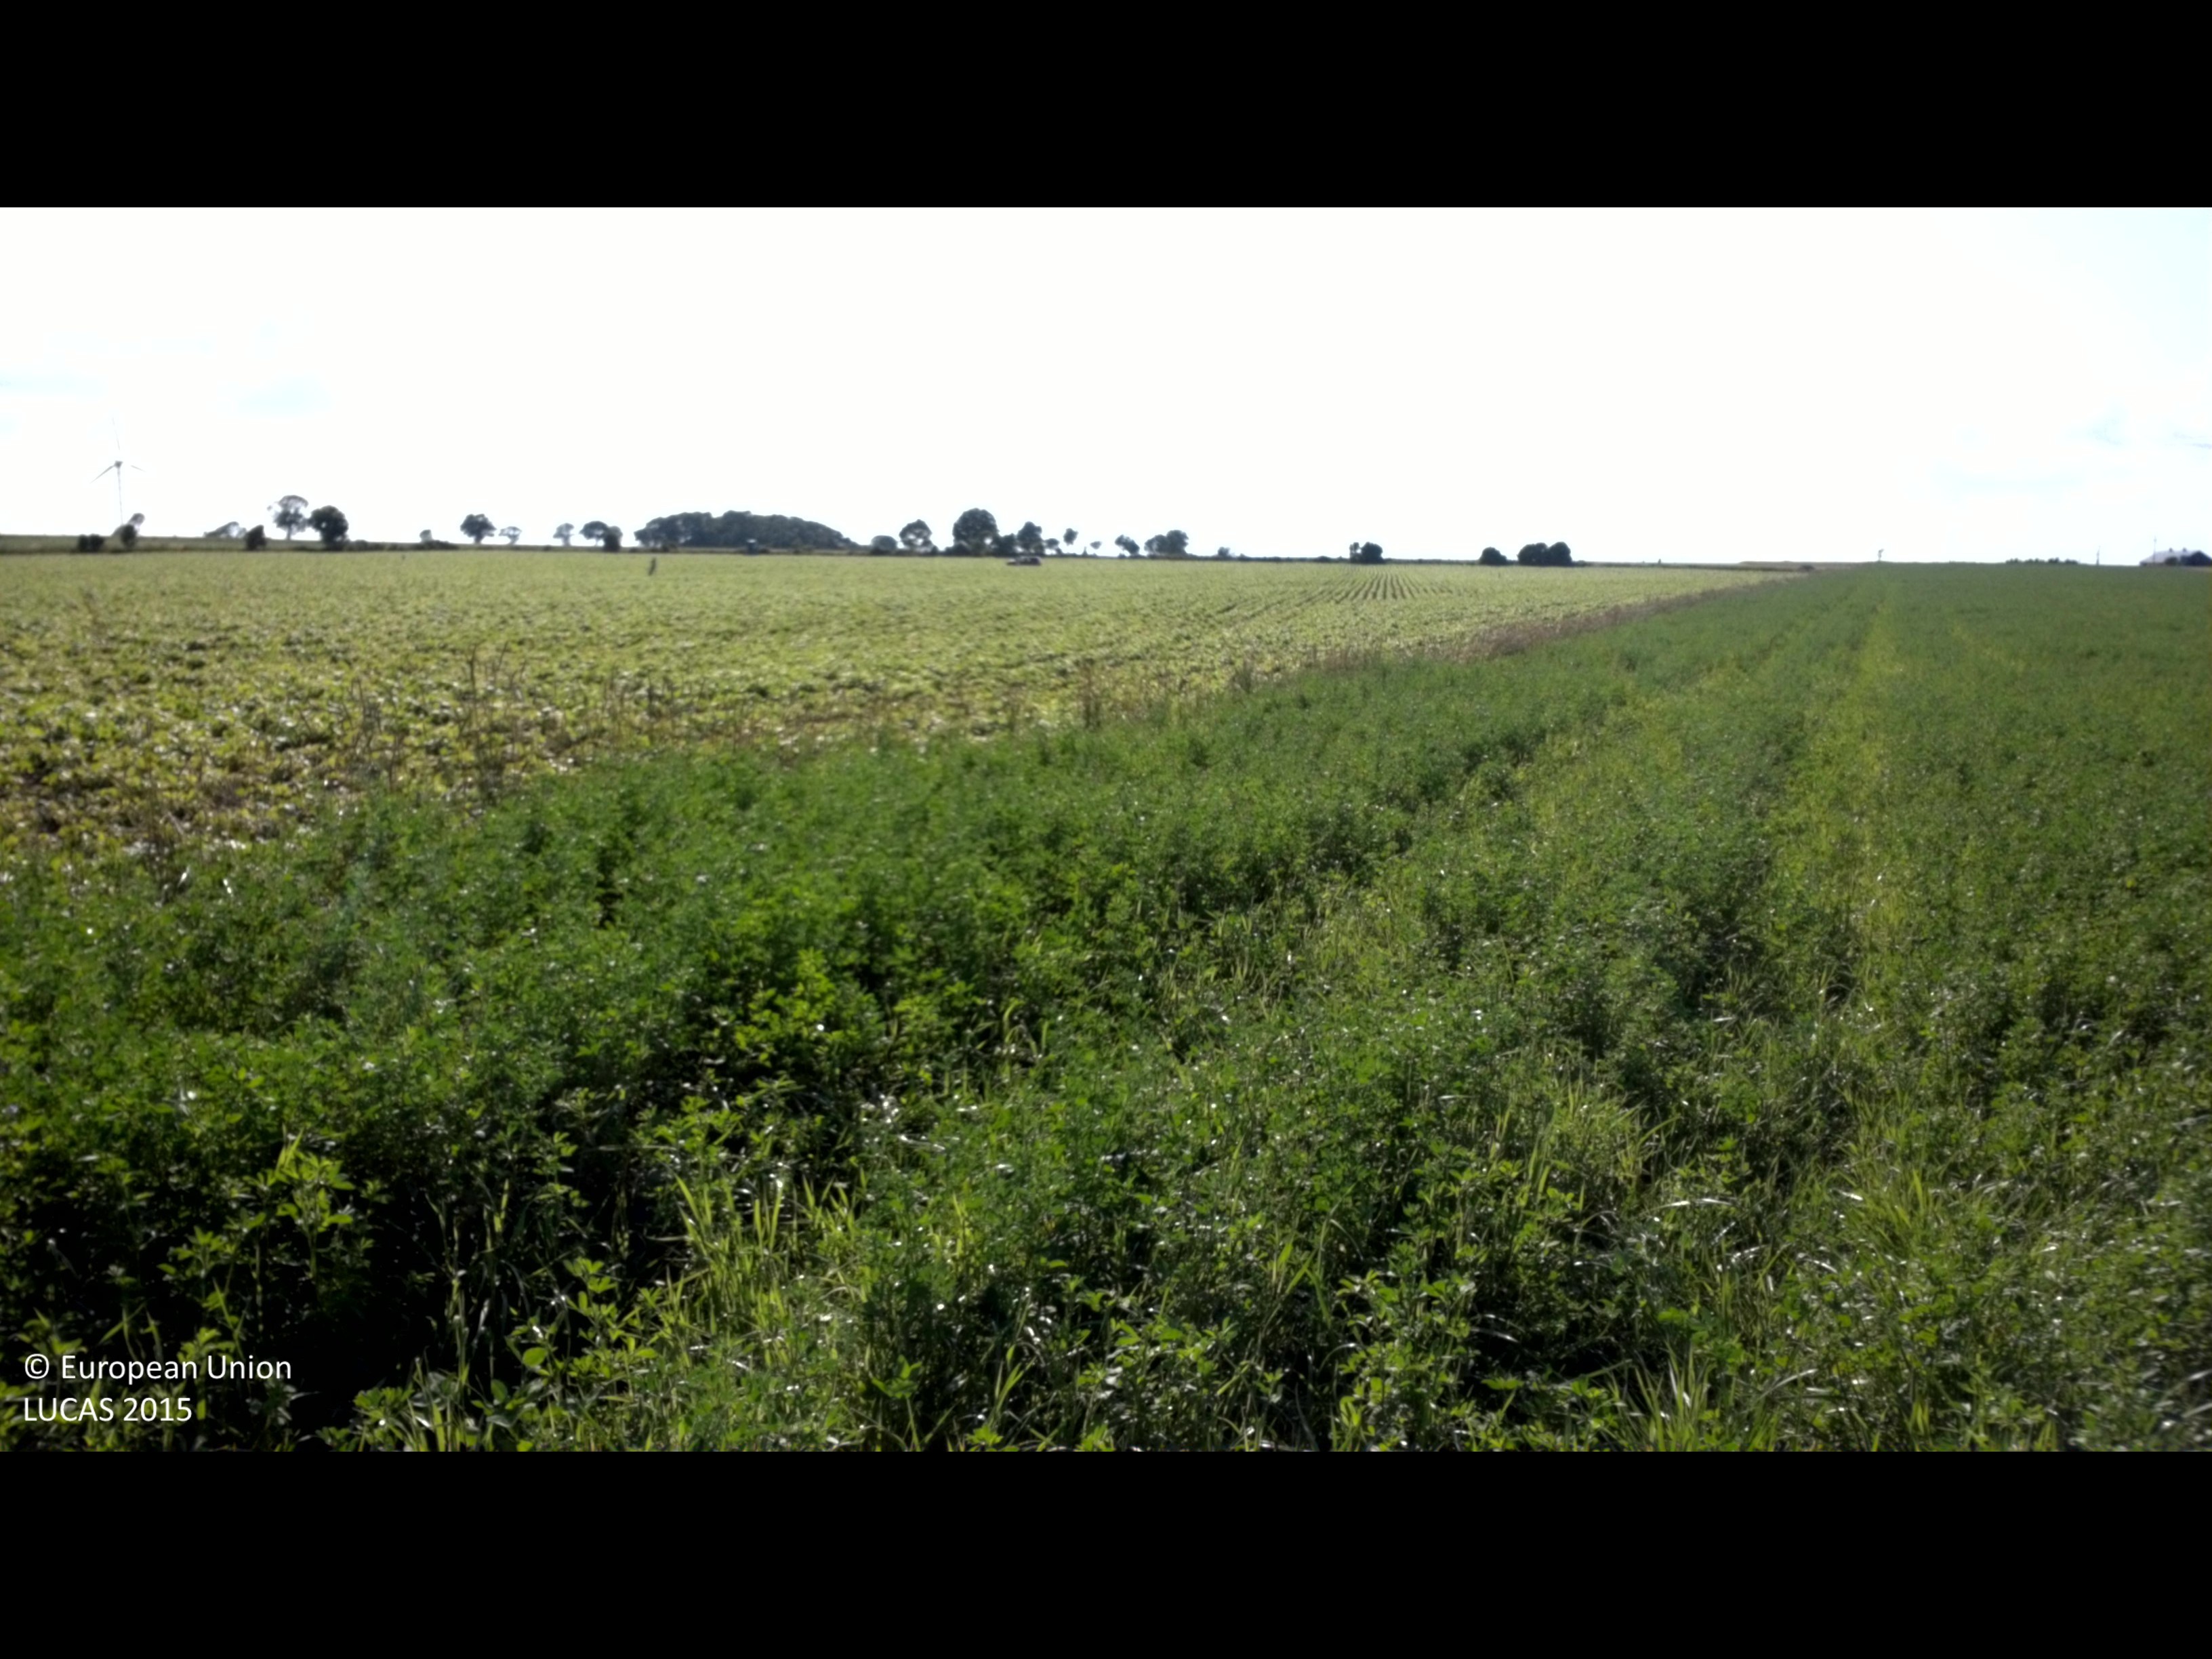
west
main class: Cropland
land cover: Lucerne
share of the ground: > 75 %
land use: Agriculture (excluding fallow land and kitchen gardens)
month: July
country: SE
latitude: 56.3873
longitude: 16.4321
